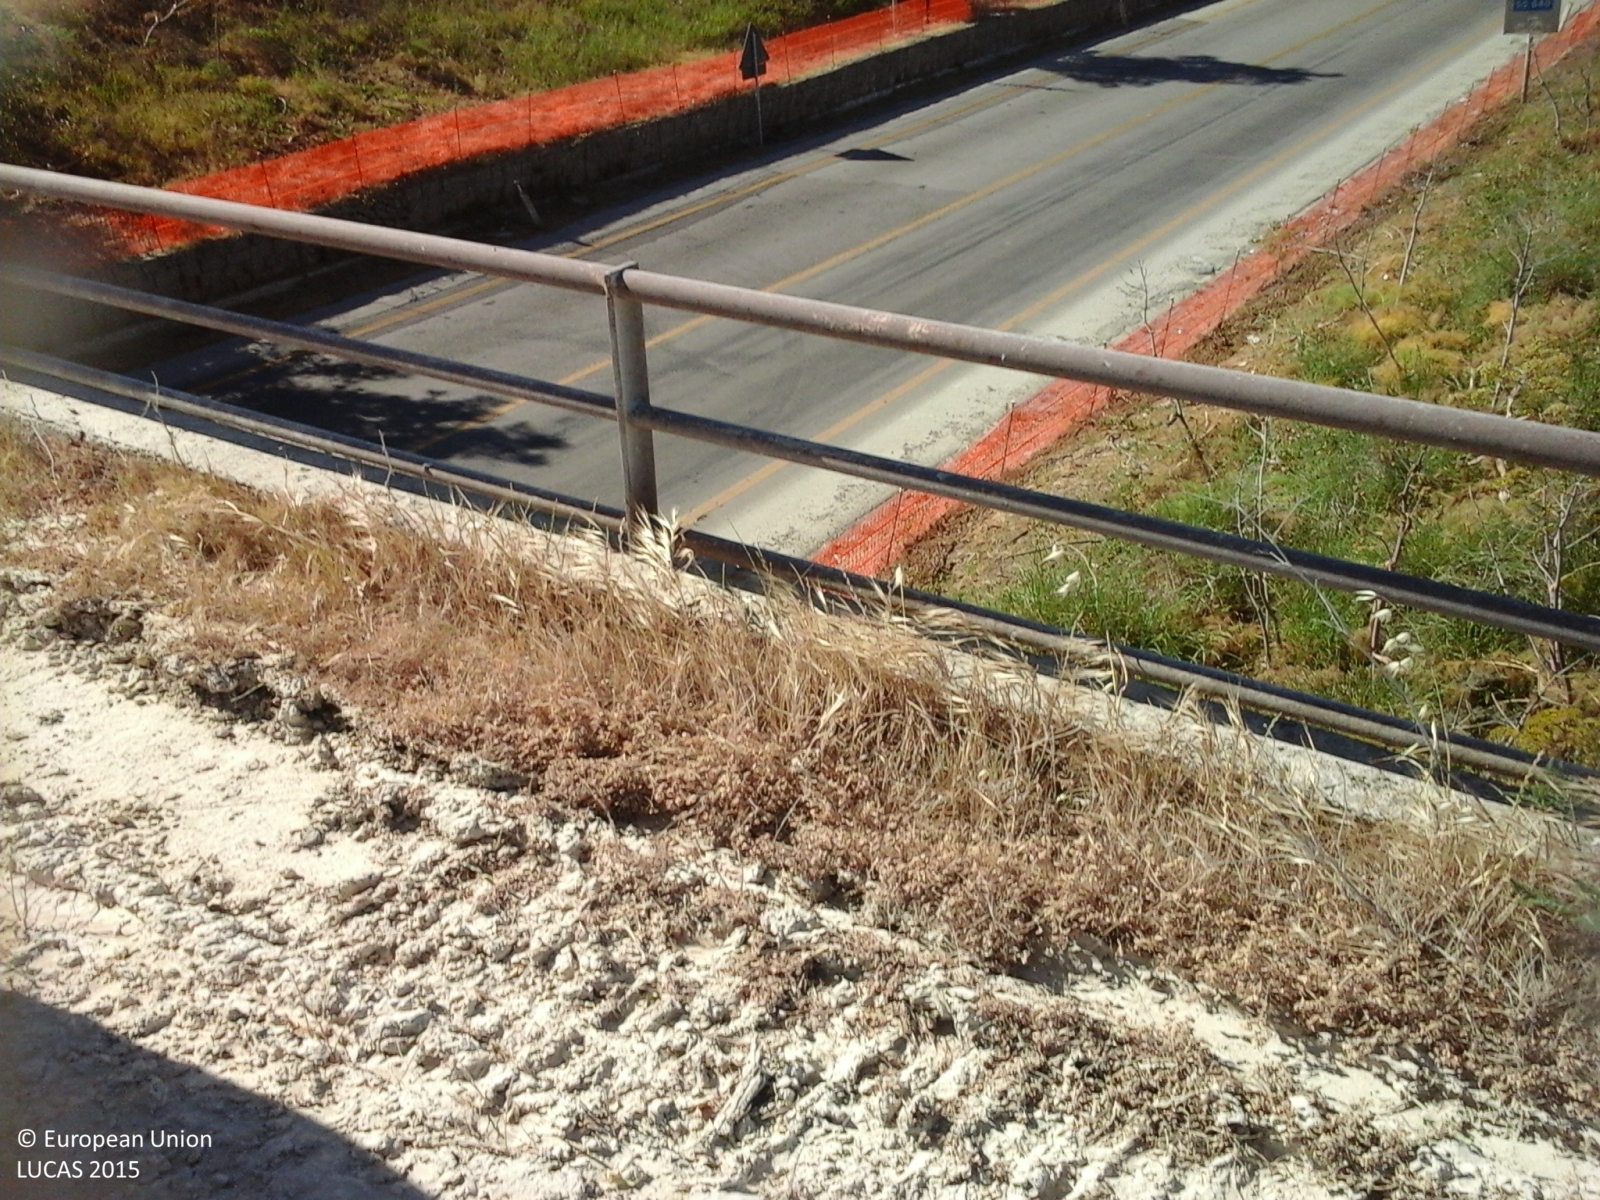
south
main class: Cropland
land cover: Durum wheat
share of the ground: > 75 %
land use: Agriculture (excluding fallow land and kitchen gardens)
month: May
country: IT
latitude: 37.4298
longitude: 13.9368
